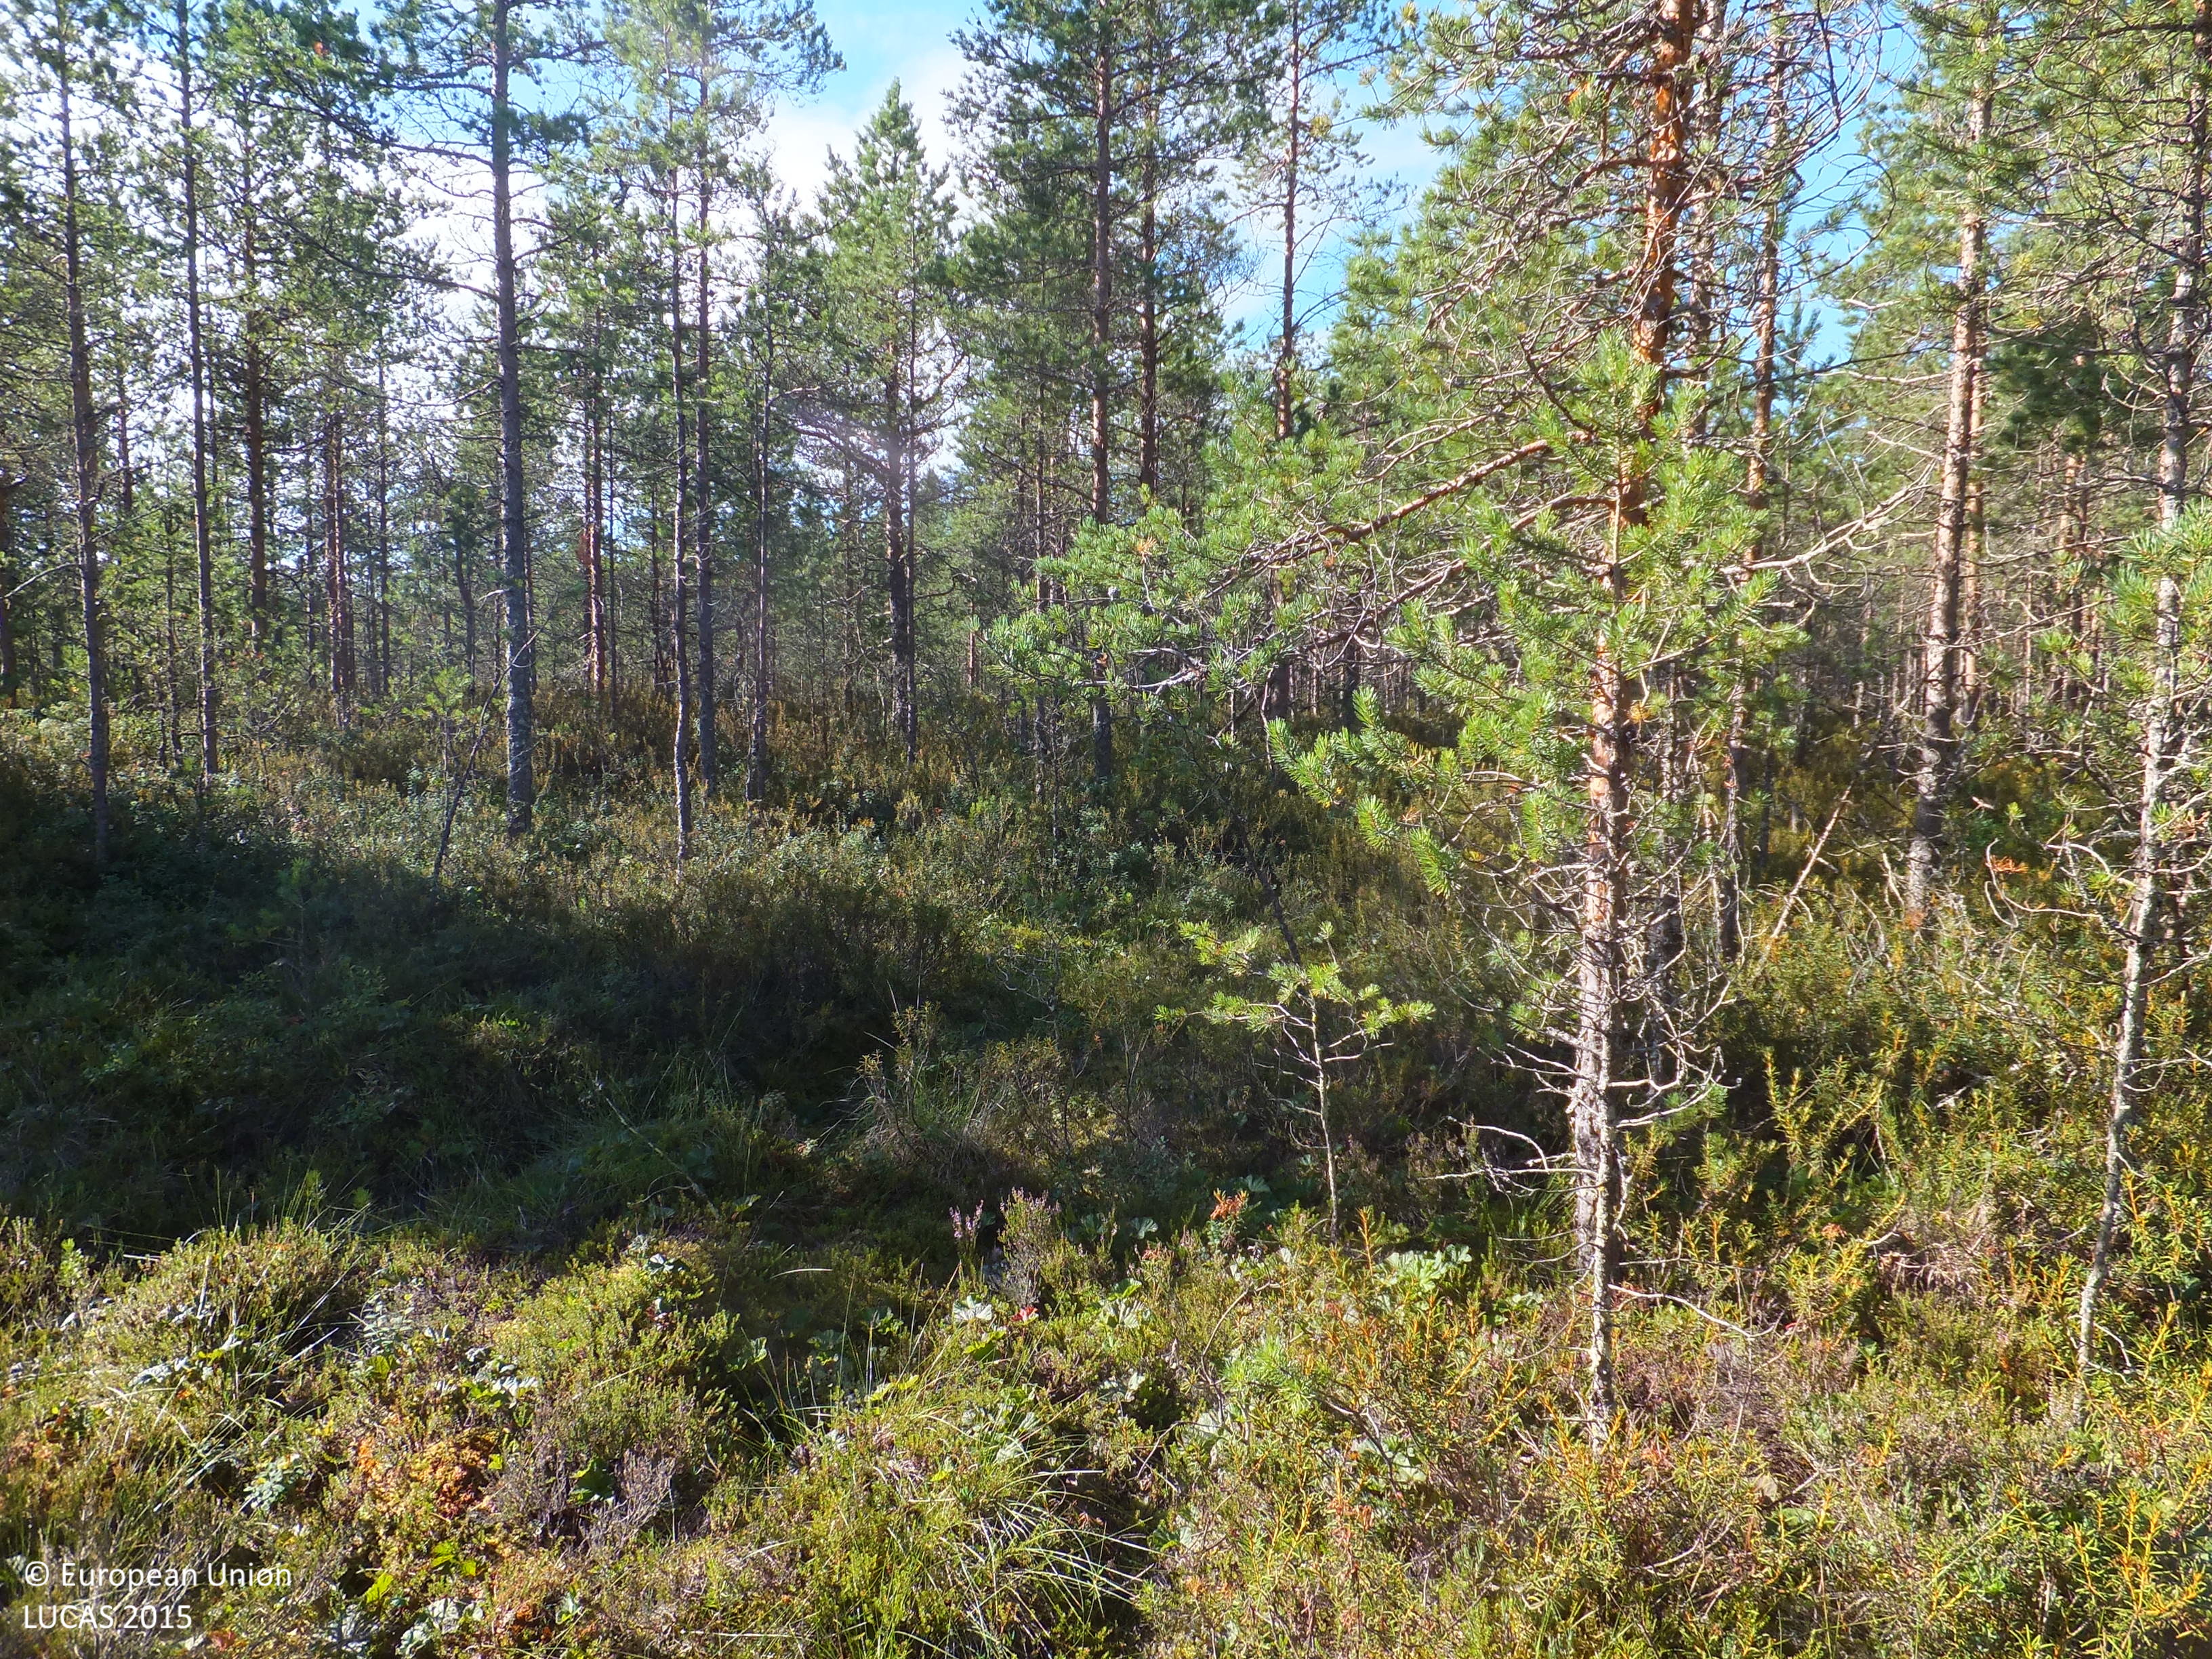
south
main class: Woodland
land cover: Pine dominated coniferous woodland
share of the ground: 50 - 75 %
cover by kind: coniferous forest trees 50 %, shrubs 30 %, lichens and mosses 15 %, herbaceous plants 5 %
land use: Forestry
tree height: < 5 m
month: August
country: FI
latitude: 63.1044
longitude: 22.8357
